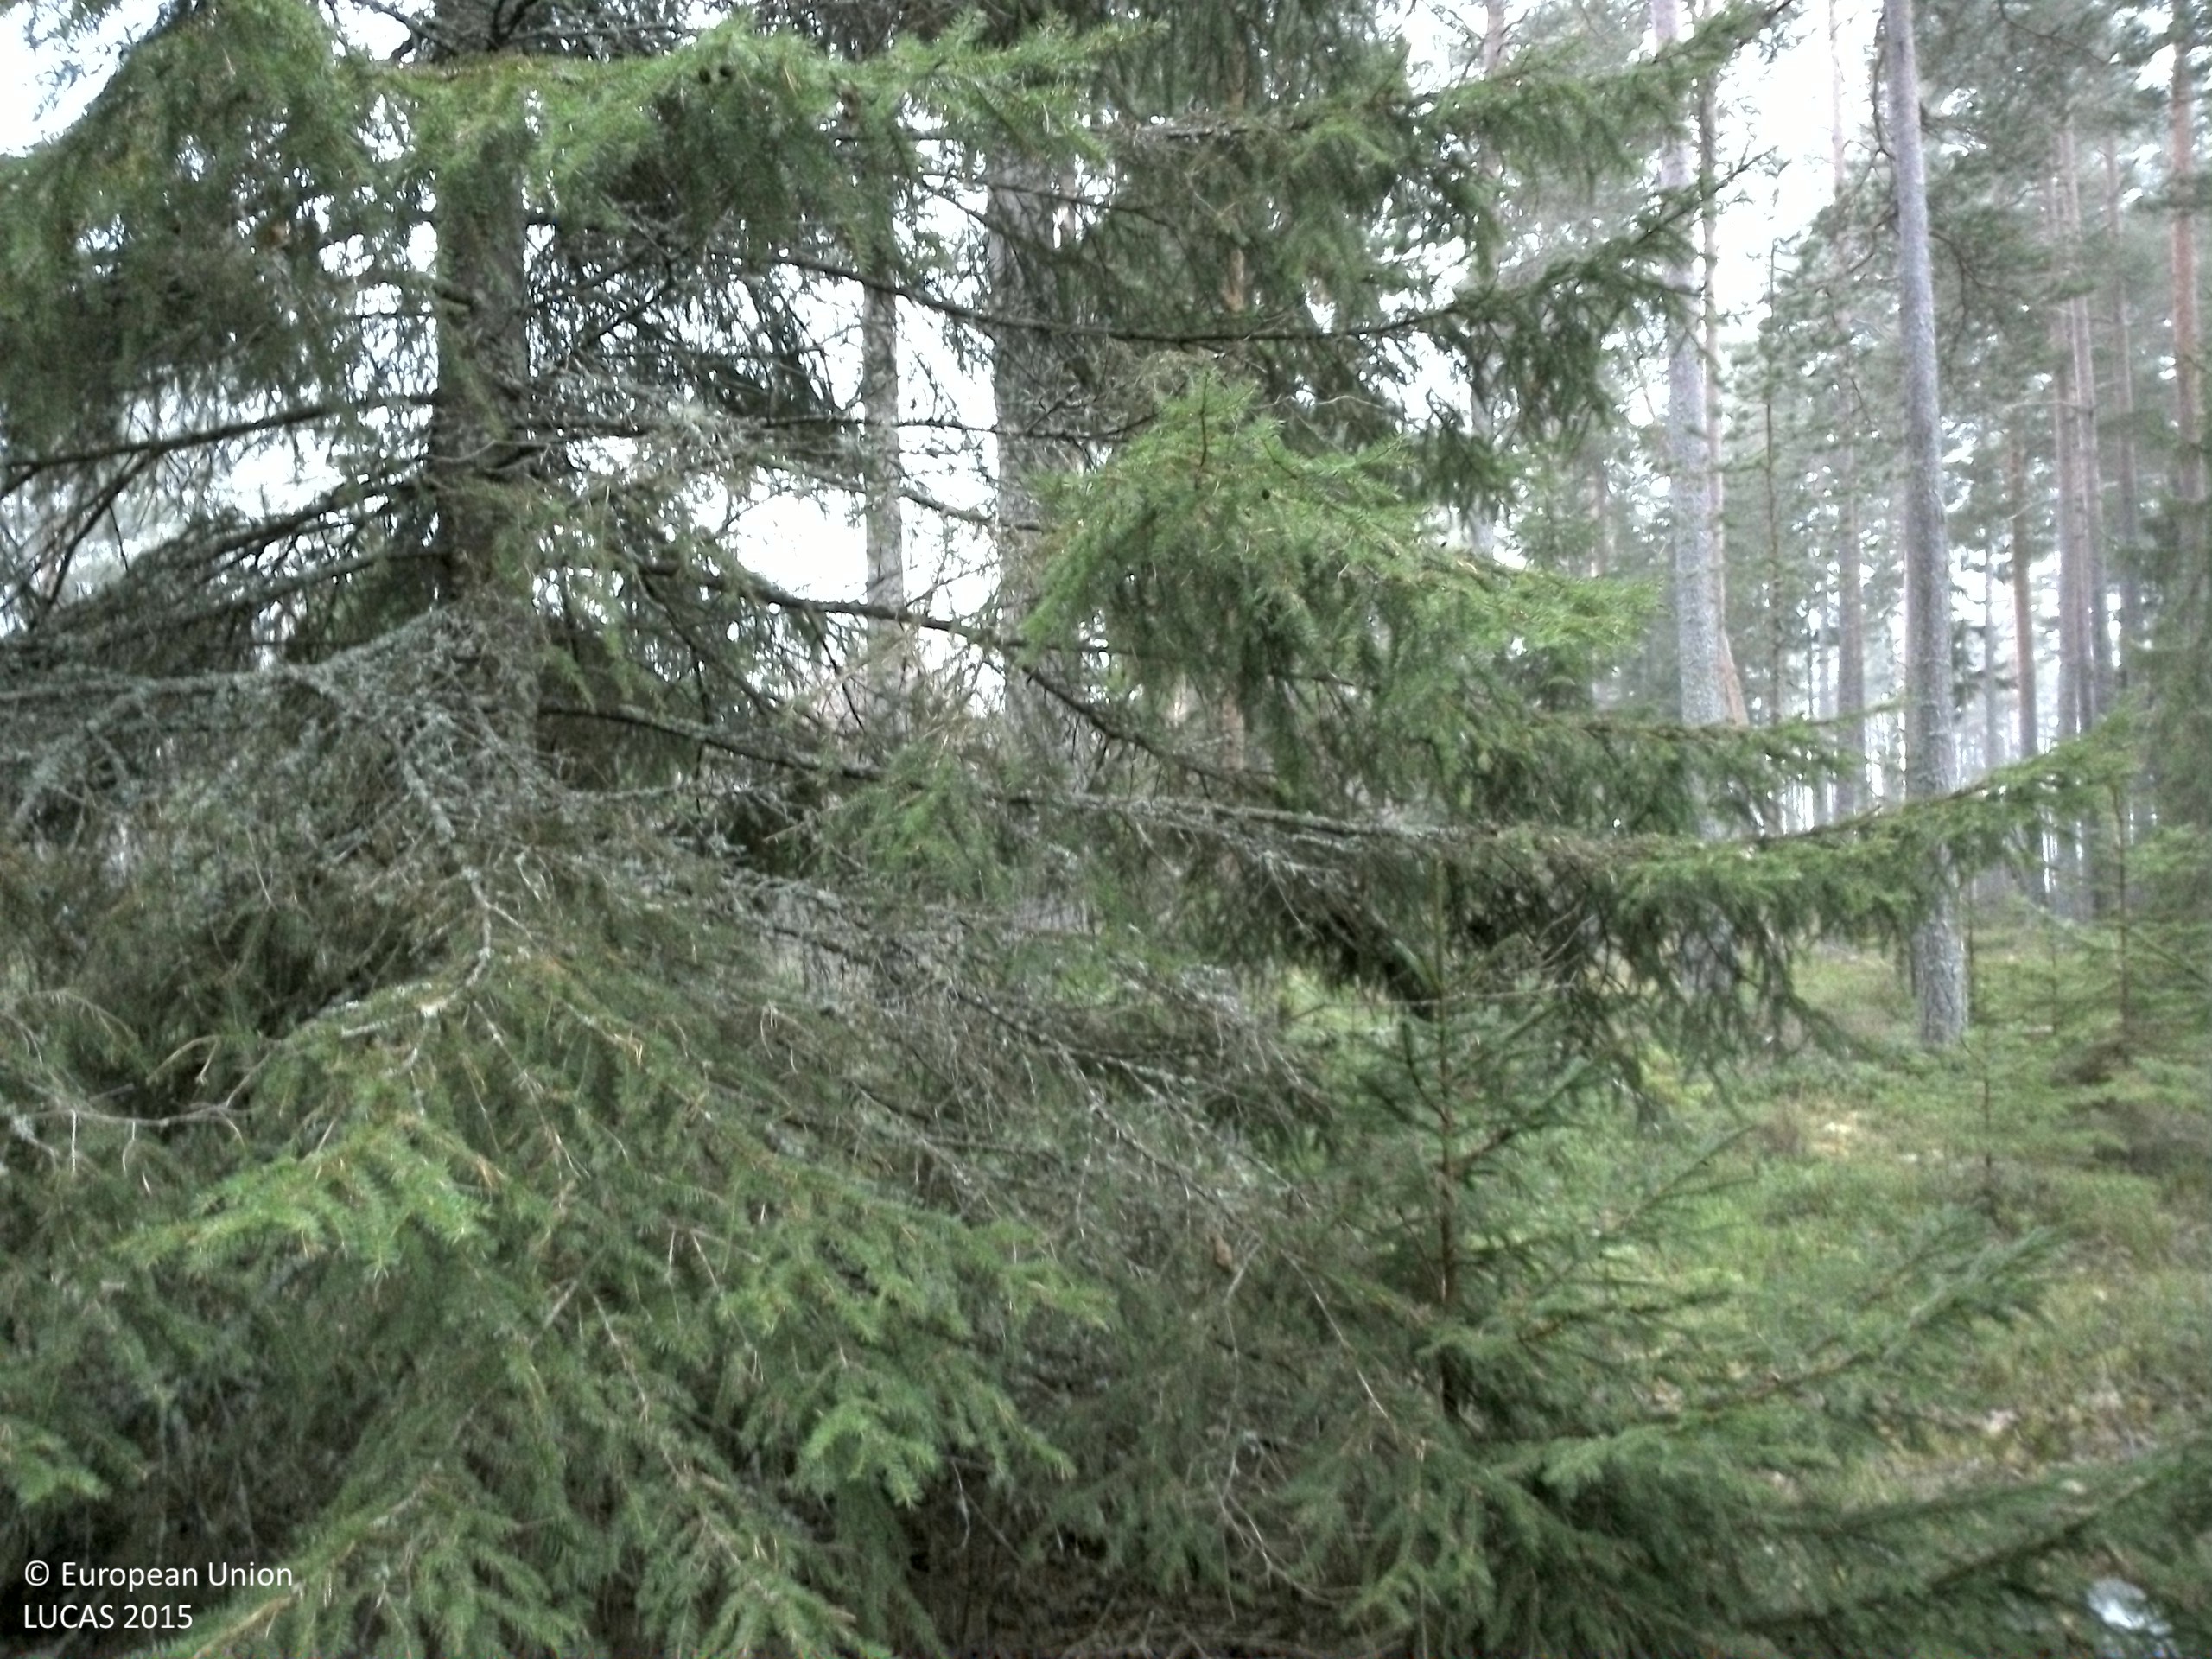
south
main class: Woodland
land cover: Other coniferous woodland
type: boreal forest
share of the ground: 50 - 75 %
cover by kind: coniferous forest trees 60 %, shrubs 25 %, lichens and mosses 10 %, broadleaved forest trees 5 %
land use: Forestry
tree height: > 5 m
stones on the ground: < 10 %
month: November
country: SE
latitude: 60.3513
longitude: 16.6041
